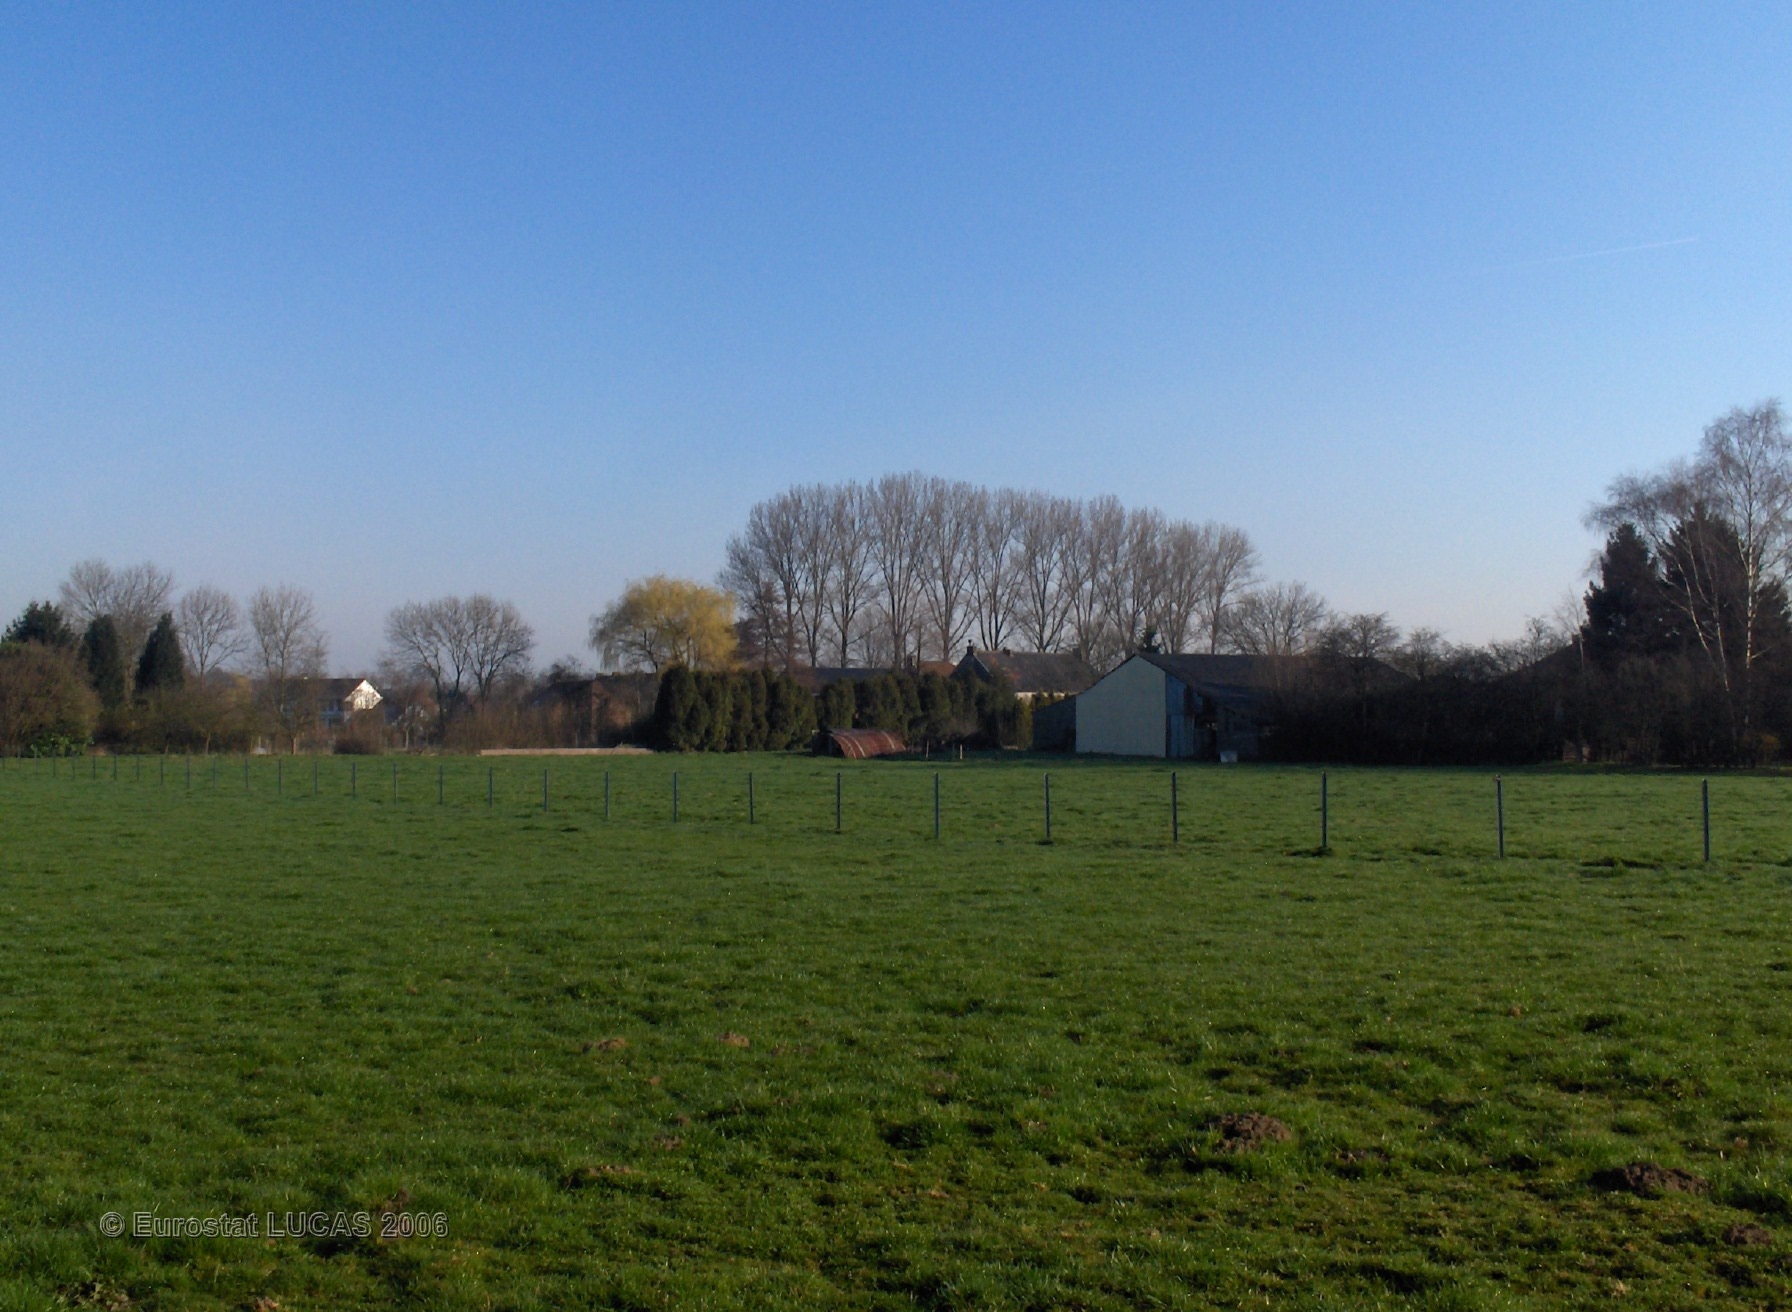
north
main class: Grassland
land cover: Grassland without tree/shrub cover
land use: Agriculture (excluding fallow land and kitchen gardens)
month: April
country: BE
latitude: 50.5013
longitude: 4.4832
